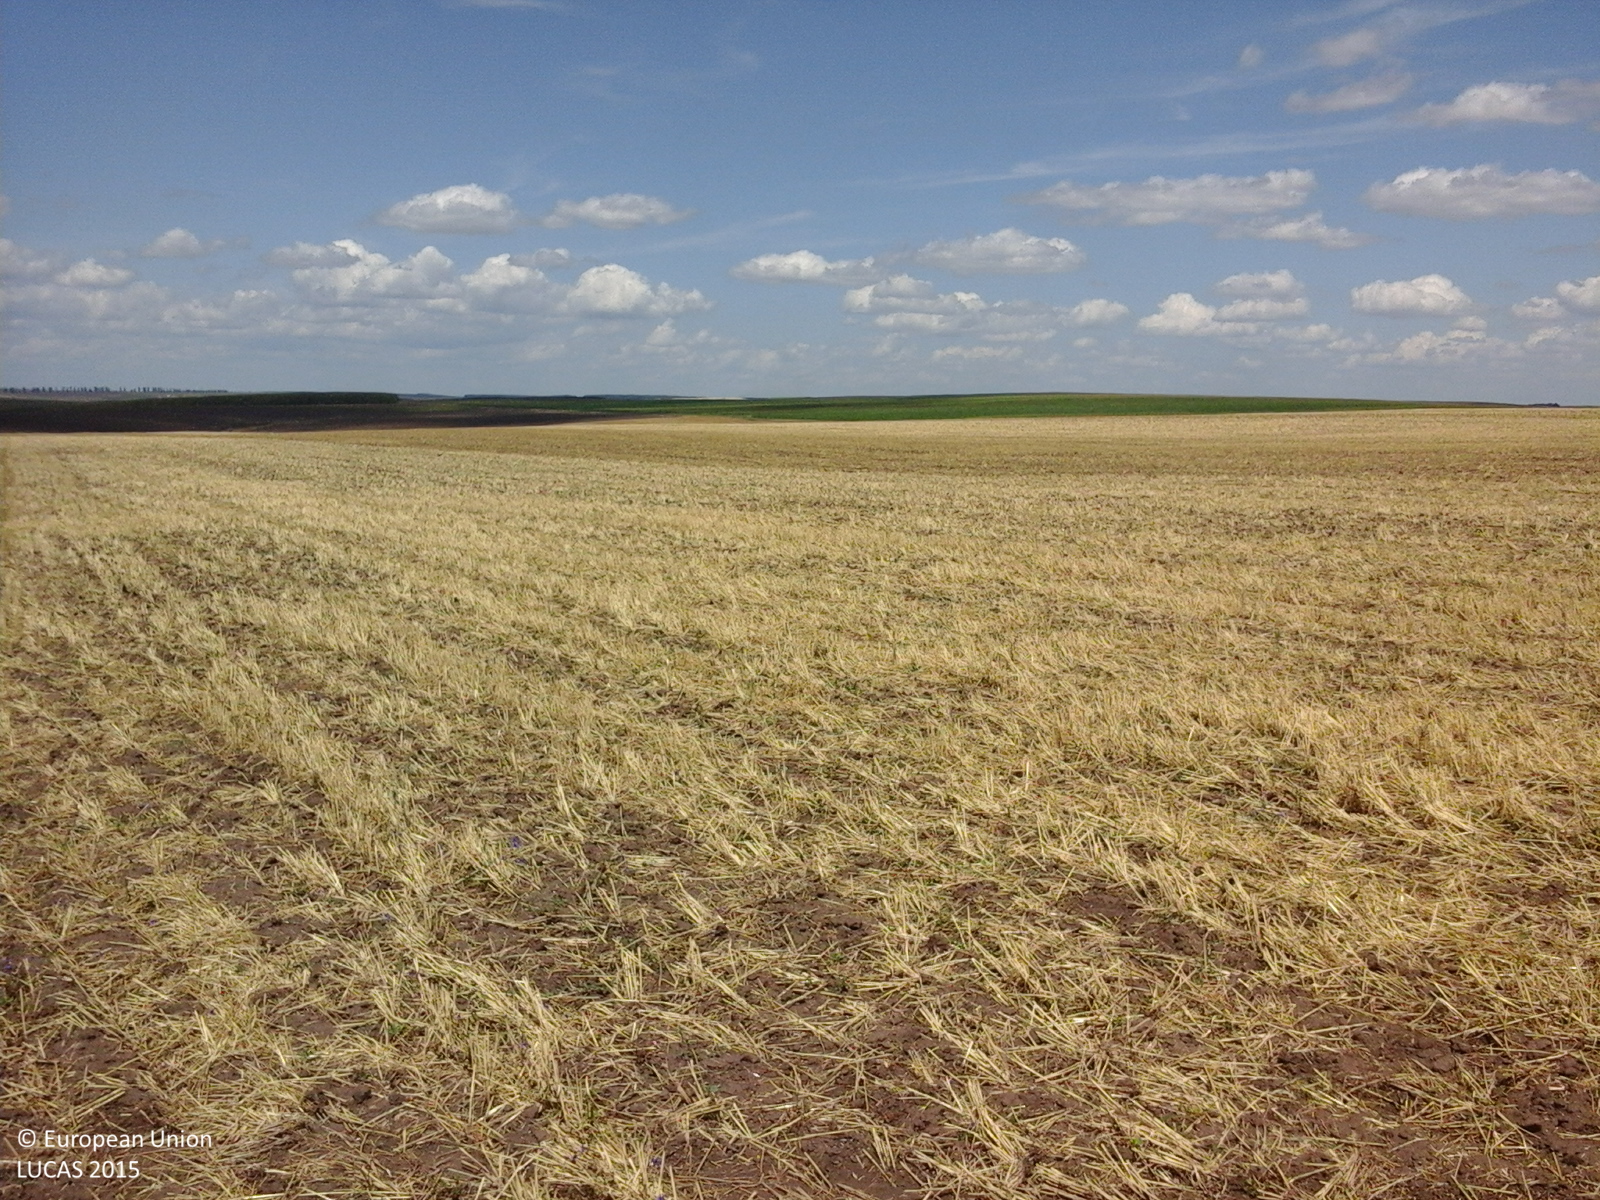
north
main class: Cropland
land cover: Common wheat
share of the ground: 25 - 50 %
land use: Agriculture (excluding fallow land and kitchen gardens)
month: July
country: RO
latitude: 45.9127
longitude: 27.6835
